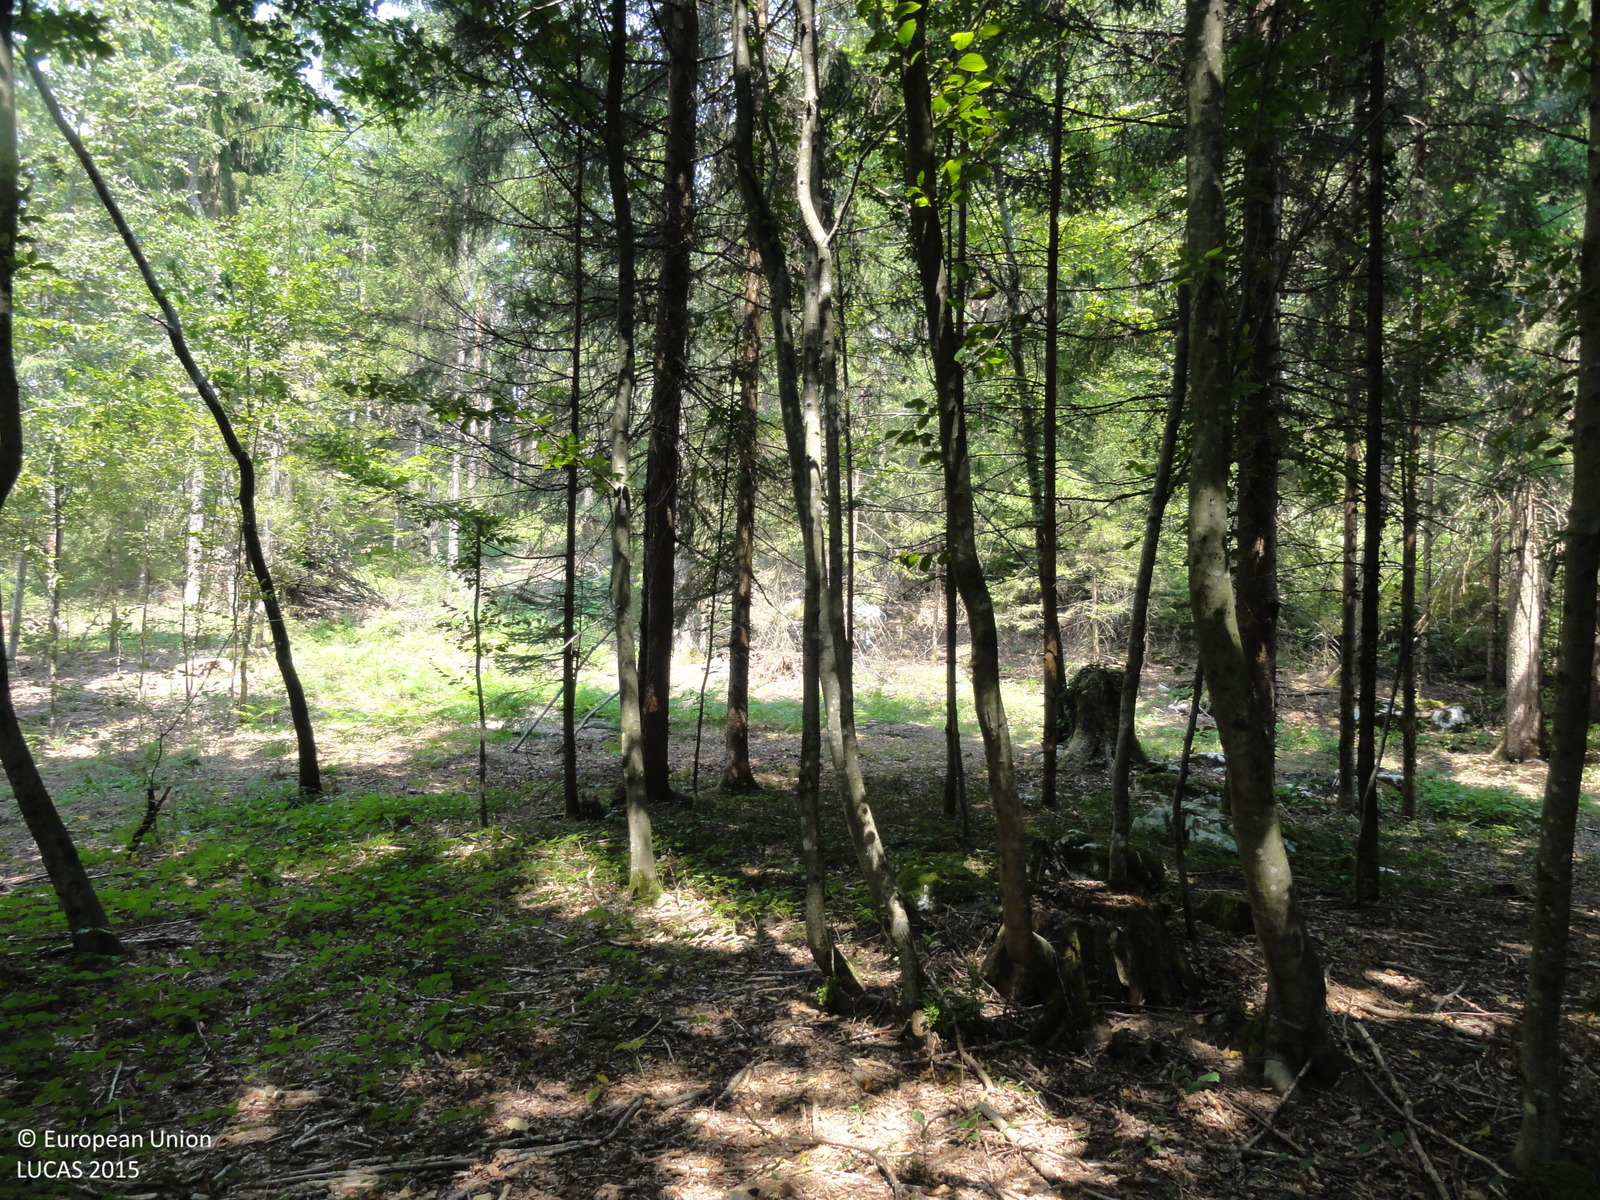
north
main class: Woodland
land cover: Spruce dominated mixed woodland
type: mountainous beech forest
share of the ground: > 75 %
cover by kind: broadleaved forest trees 65 %, coniferous forest trees 35 %
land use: Forestry
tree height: > 5 m
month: August
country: SI
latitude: 45.7782
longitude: 15.1023
